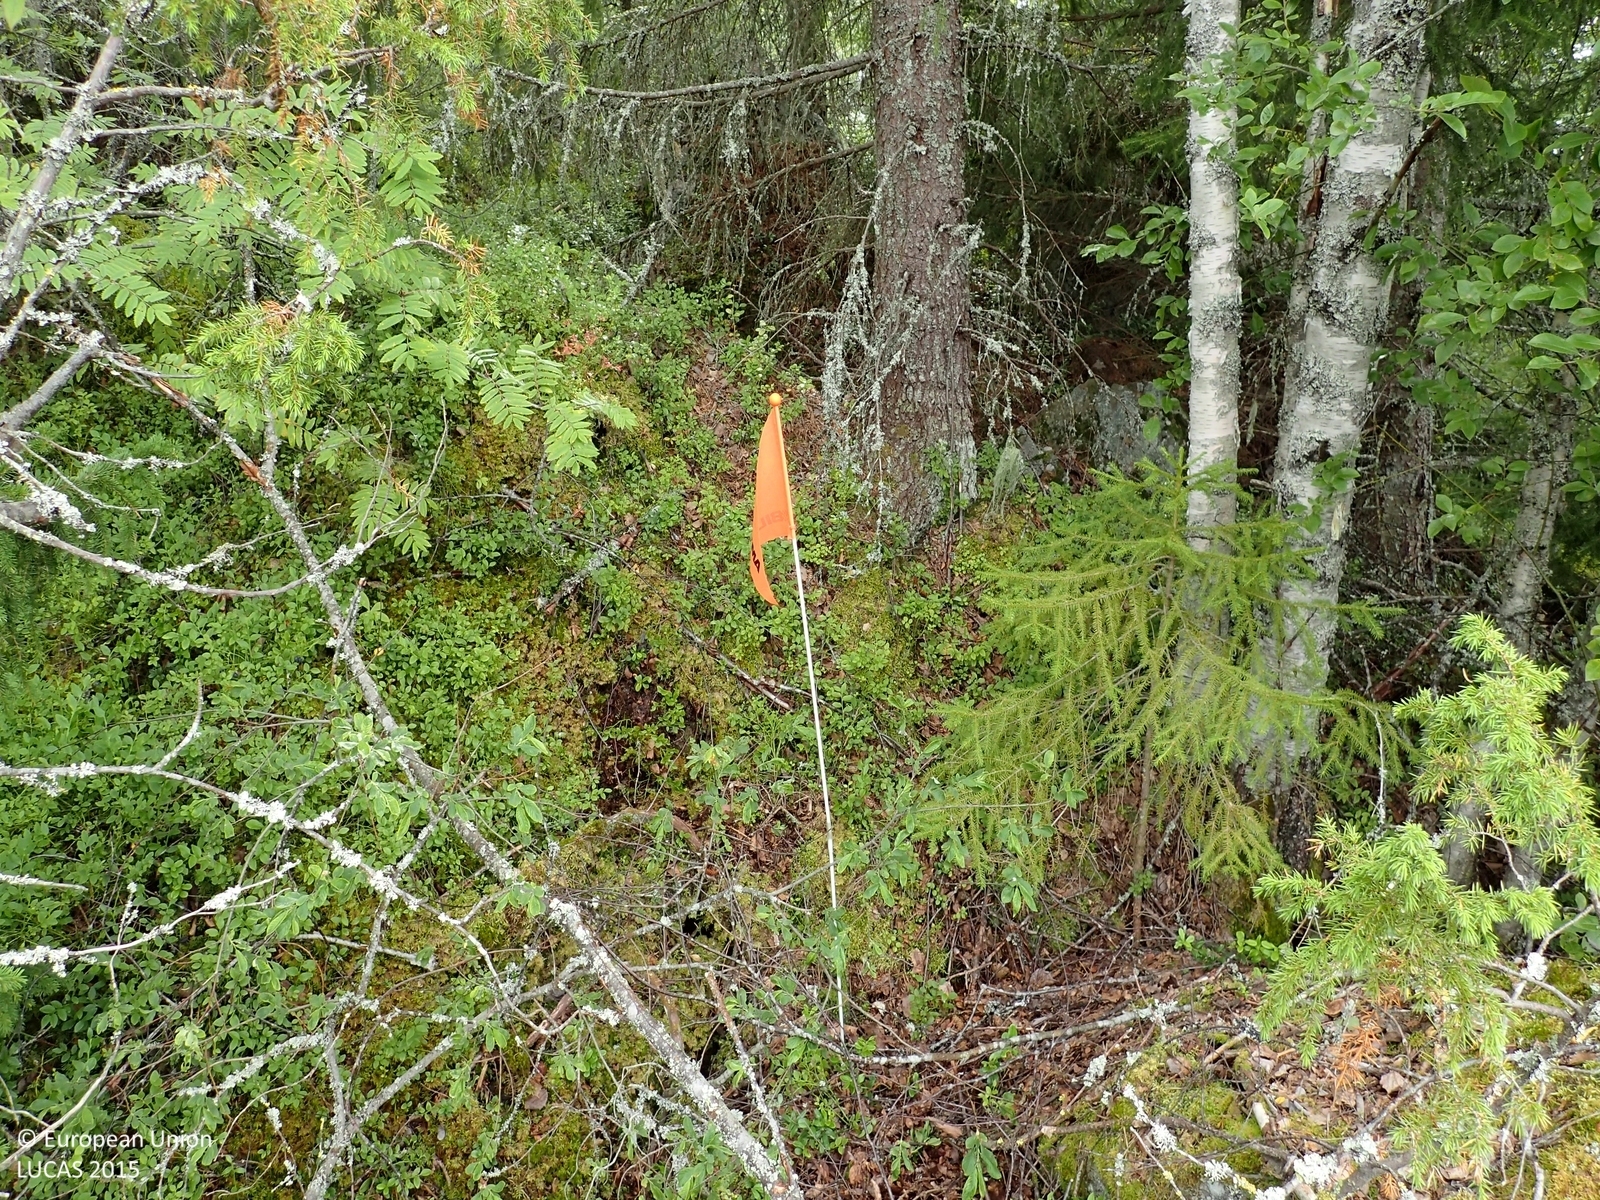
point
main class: Woodland
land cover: Other mixed woodland
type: boreal forest
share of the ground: > 75 %
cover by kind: coniferous forest trees 55 %, broadleaved forest trees 20 %, shrubs 20 %, lichens and mosses 5 %
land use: Forestry
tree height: > 5 m
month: August
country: FI
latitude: 62.7959
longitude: 21.9080
